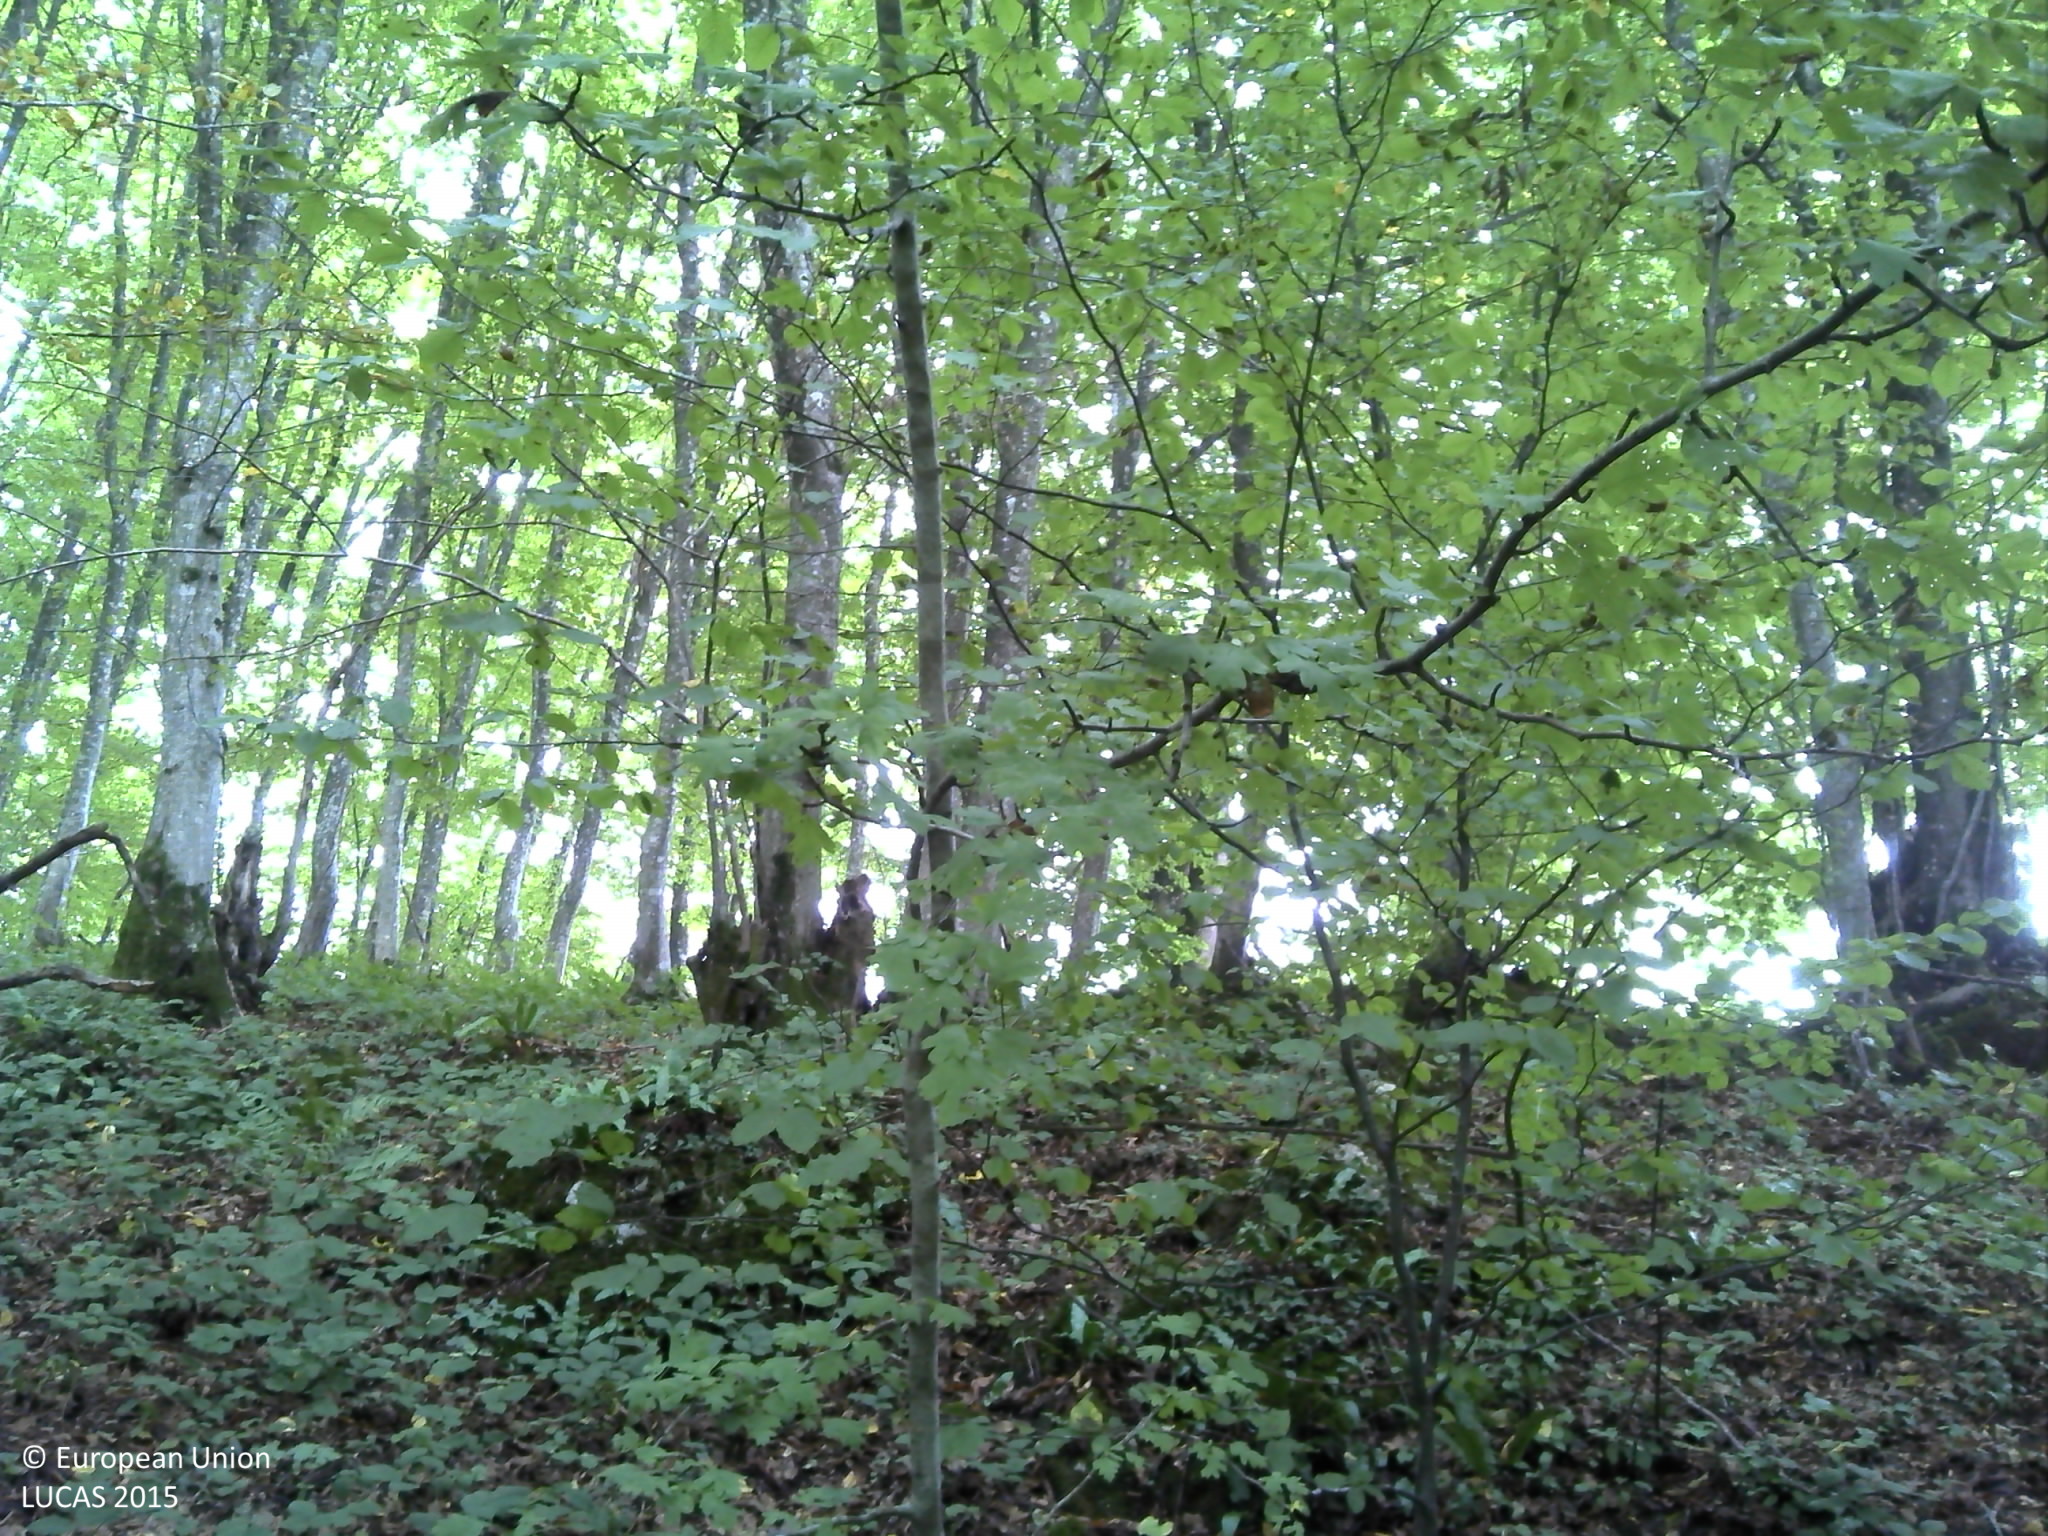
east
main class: Woodland
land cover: Broadleaved woodland
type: beech forest
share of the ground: > 75 %
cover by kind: broadleaved forest trees 100 %
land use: Forestry
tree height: > 5 m
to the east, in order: Broadleaved woodland; Artificial constructions in urban areas; Electric lines; Shrubland with sparse tree cover; Electric lines; Broadleaved woodland; Rivers and streams
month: August
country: HR
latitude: 45.2439
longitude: 15.6650
